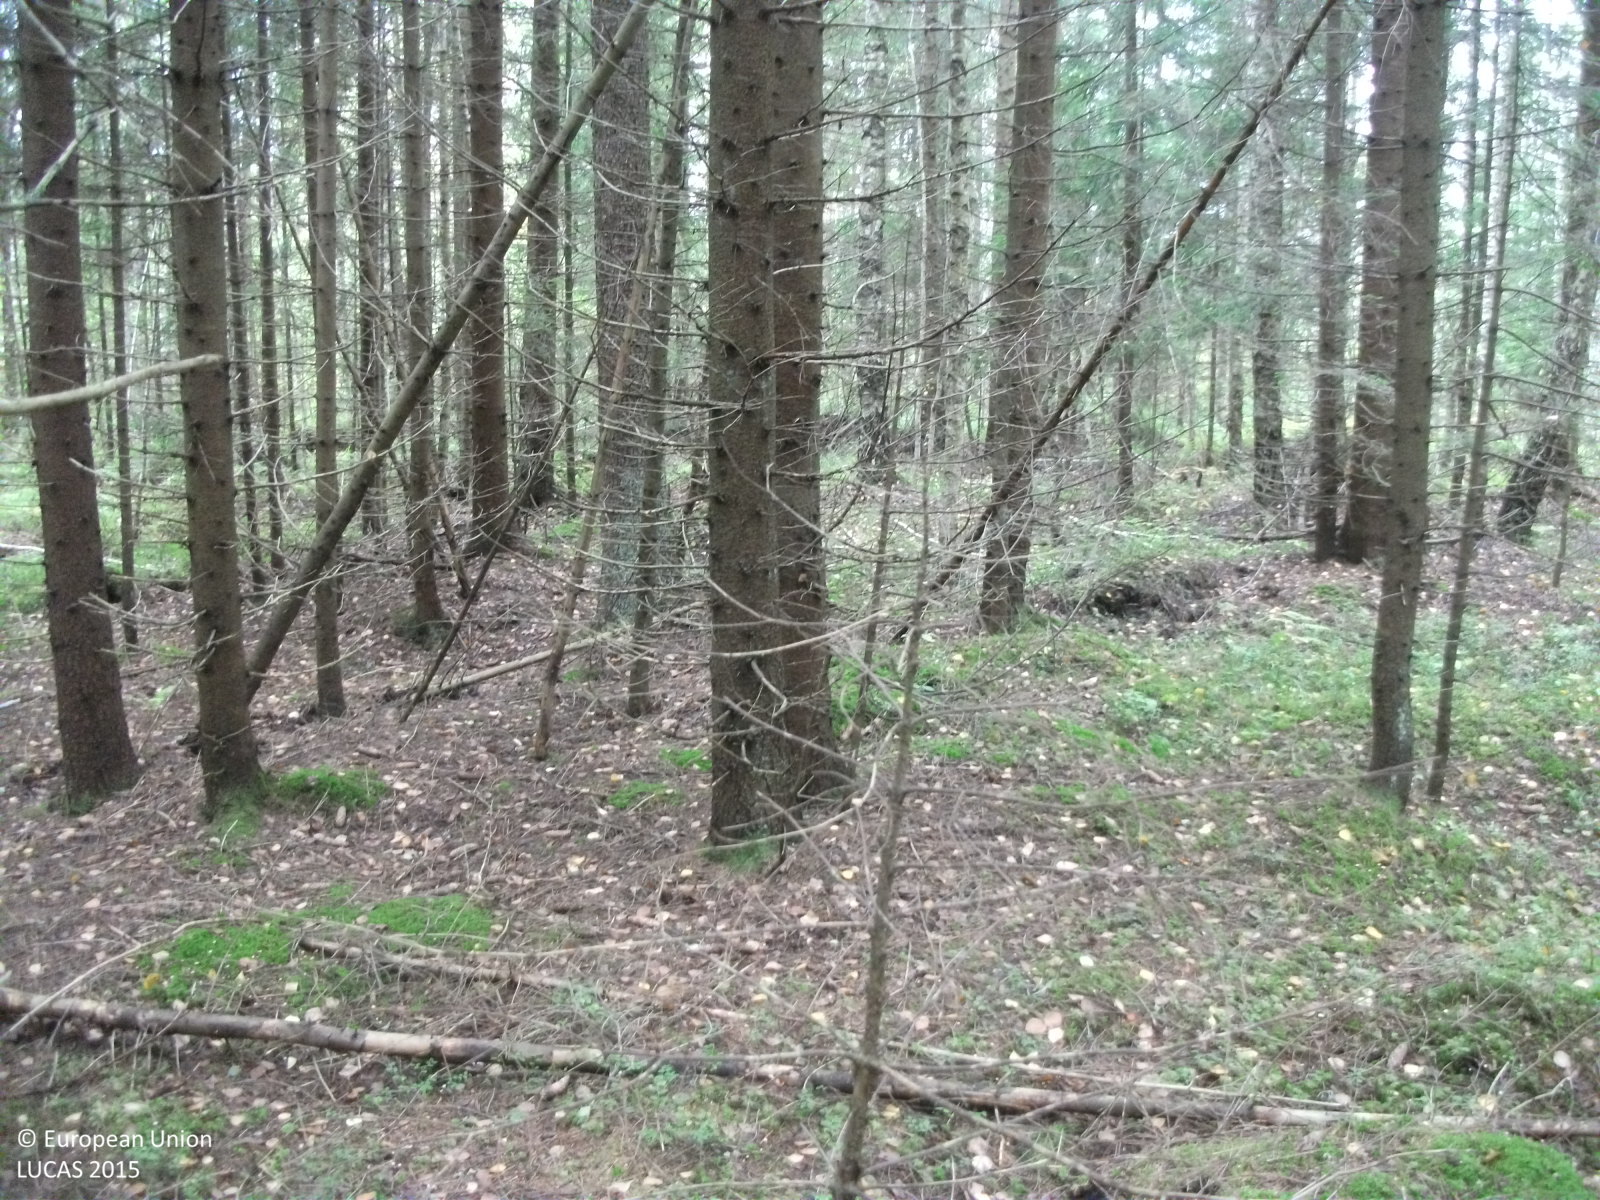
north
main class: Woodland
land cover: Spruce dominated coniferous woodland
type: hemiboreal forest and nemoral coniferous forest and mixed broadleaved-coniferous forest
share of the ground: > 75 %
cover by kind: coniferous forest trees 85 %, broadleaved forest trees 5 %, herbaceous plants 5 %, lichens and mosses 5 %
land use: Forestry
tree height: > 5 m
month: September
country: LV
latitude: 57.6664
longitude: 24.4898
